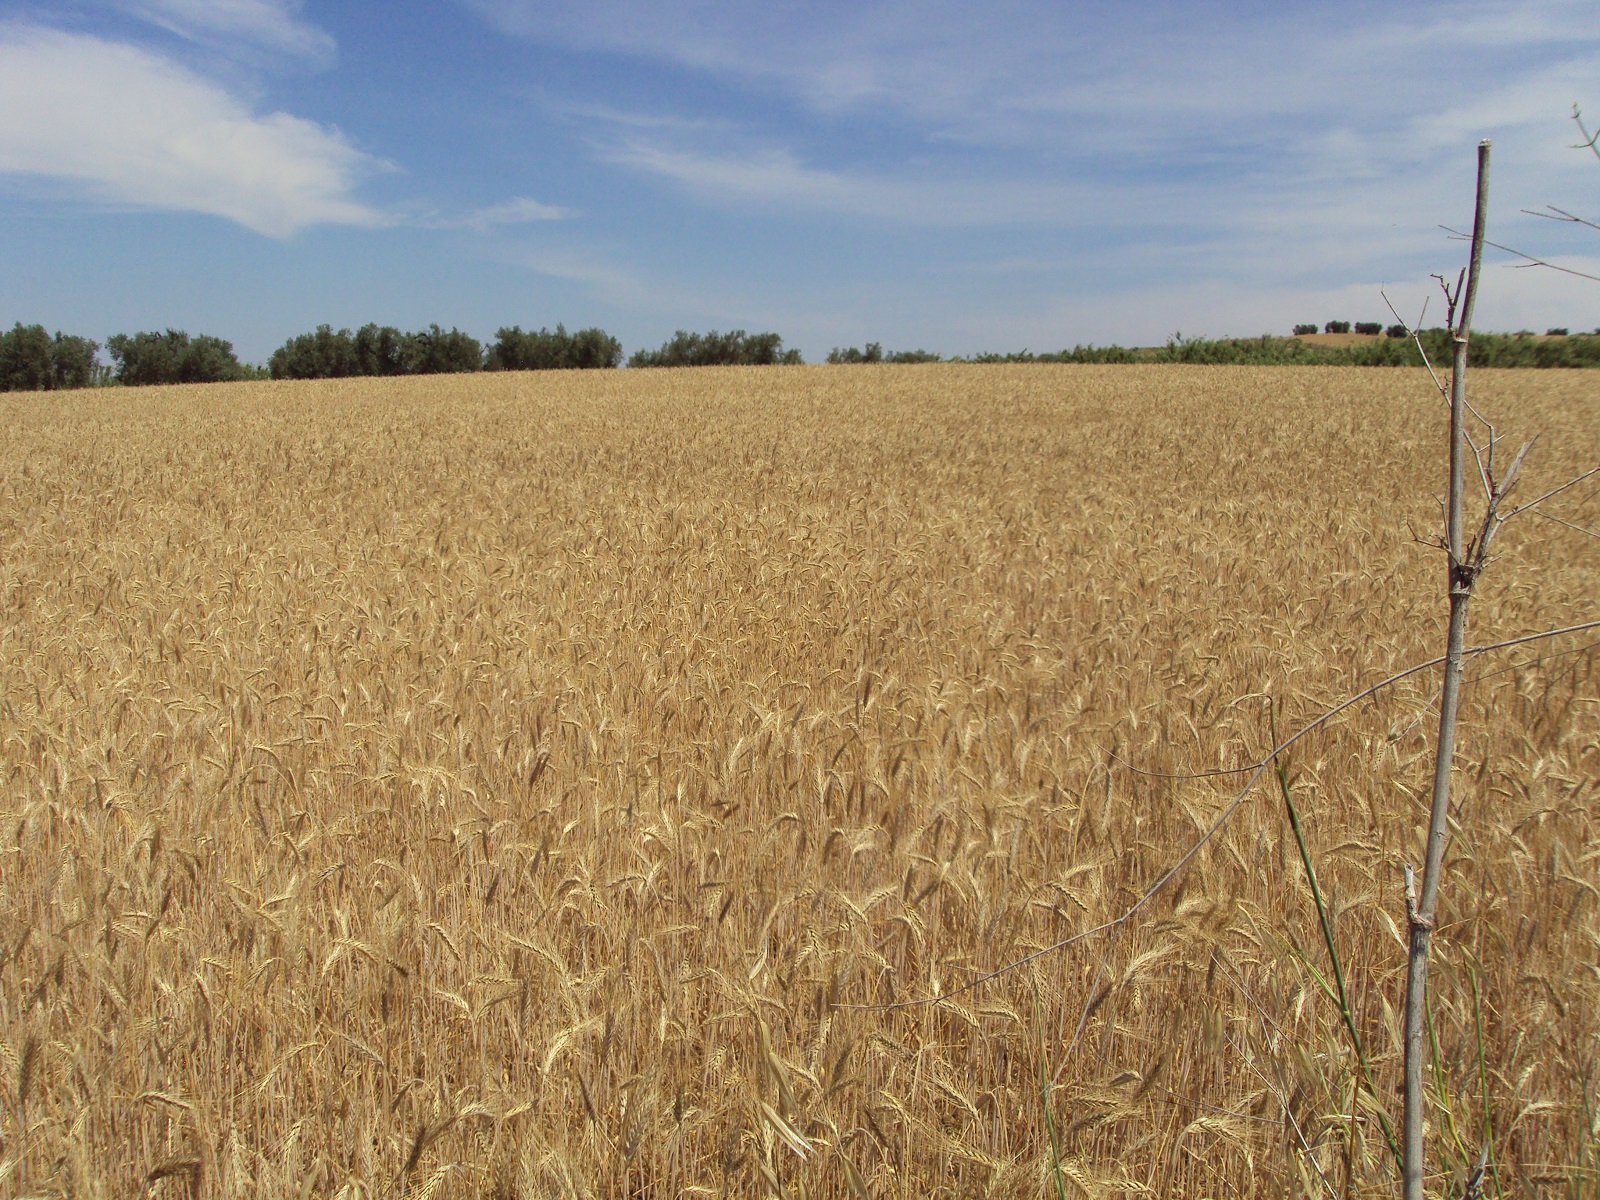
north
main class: Cropland
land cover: Barley
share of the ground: > 75 %
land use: Agriculture (excluding fallow land and kitchen gardens)
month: June
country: ES
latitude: 37.3631
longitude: -6.6205
